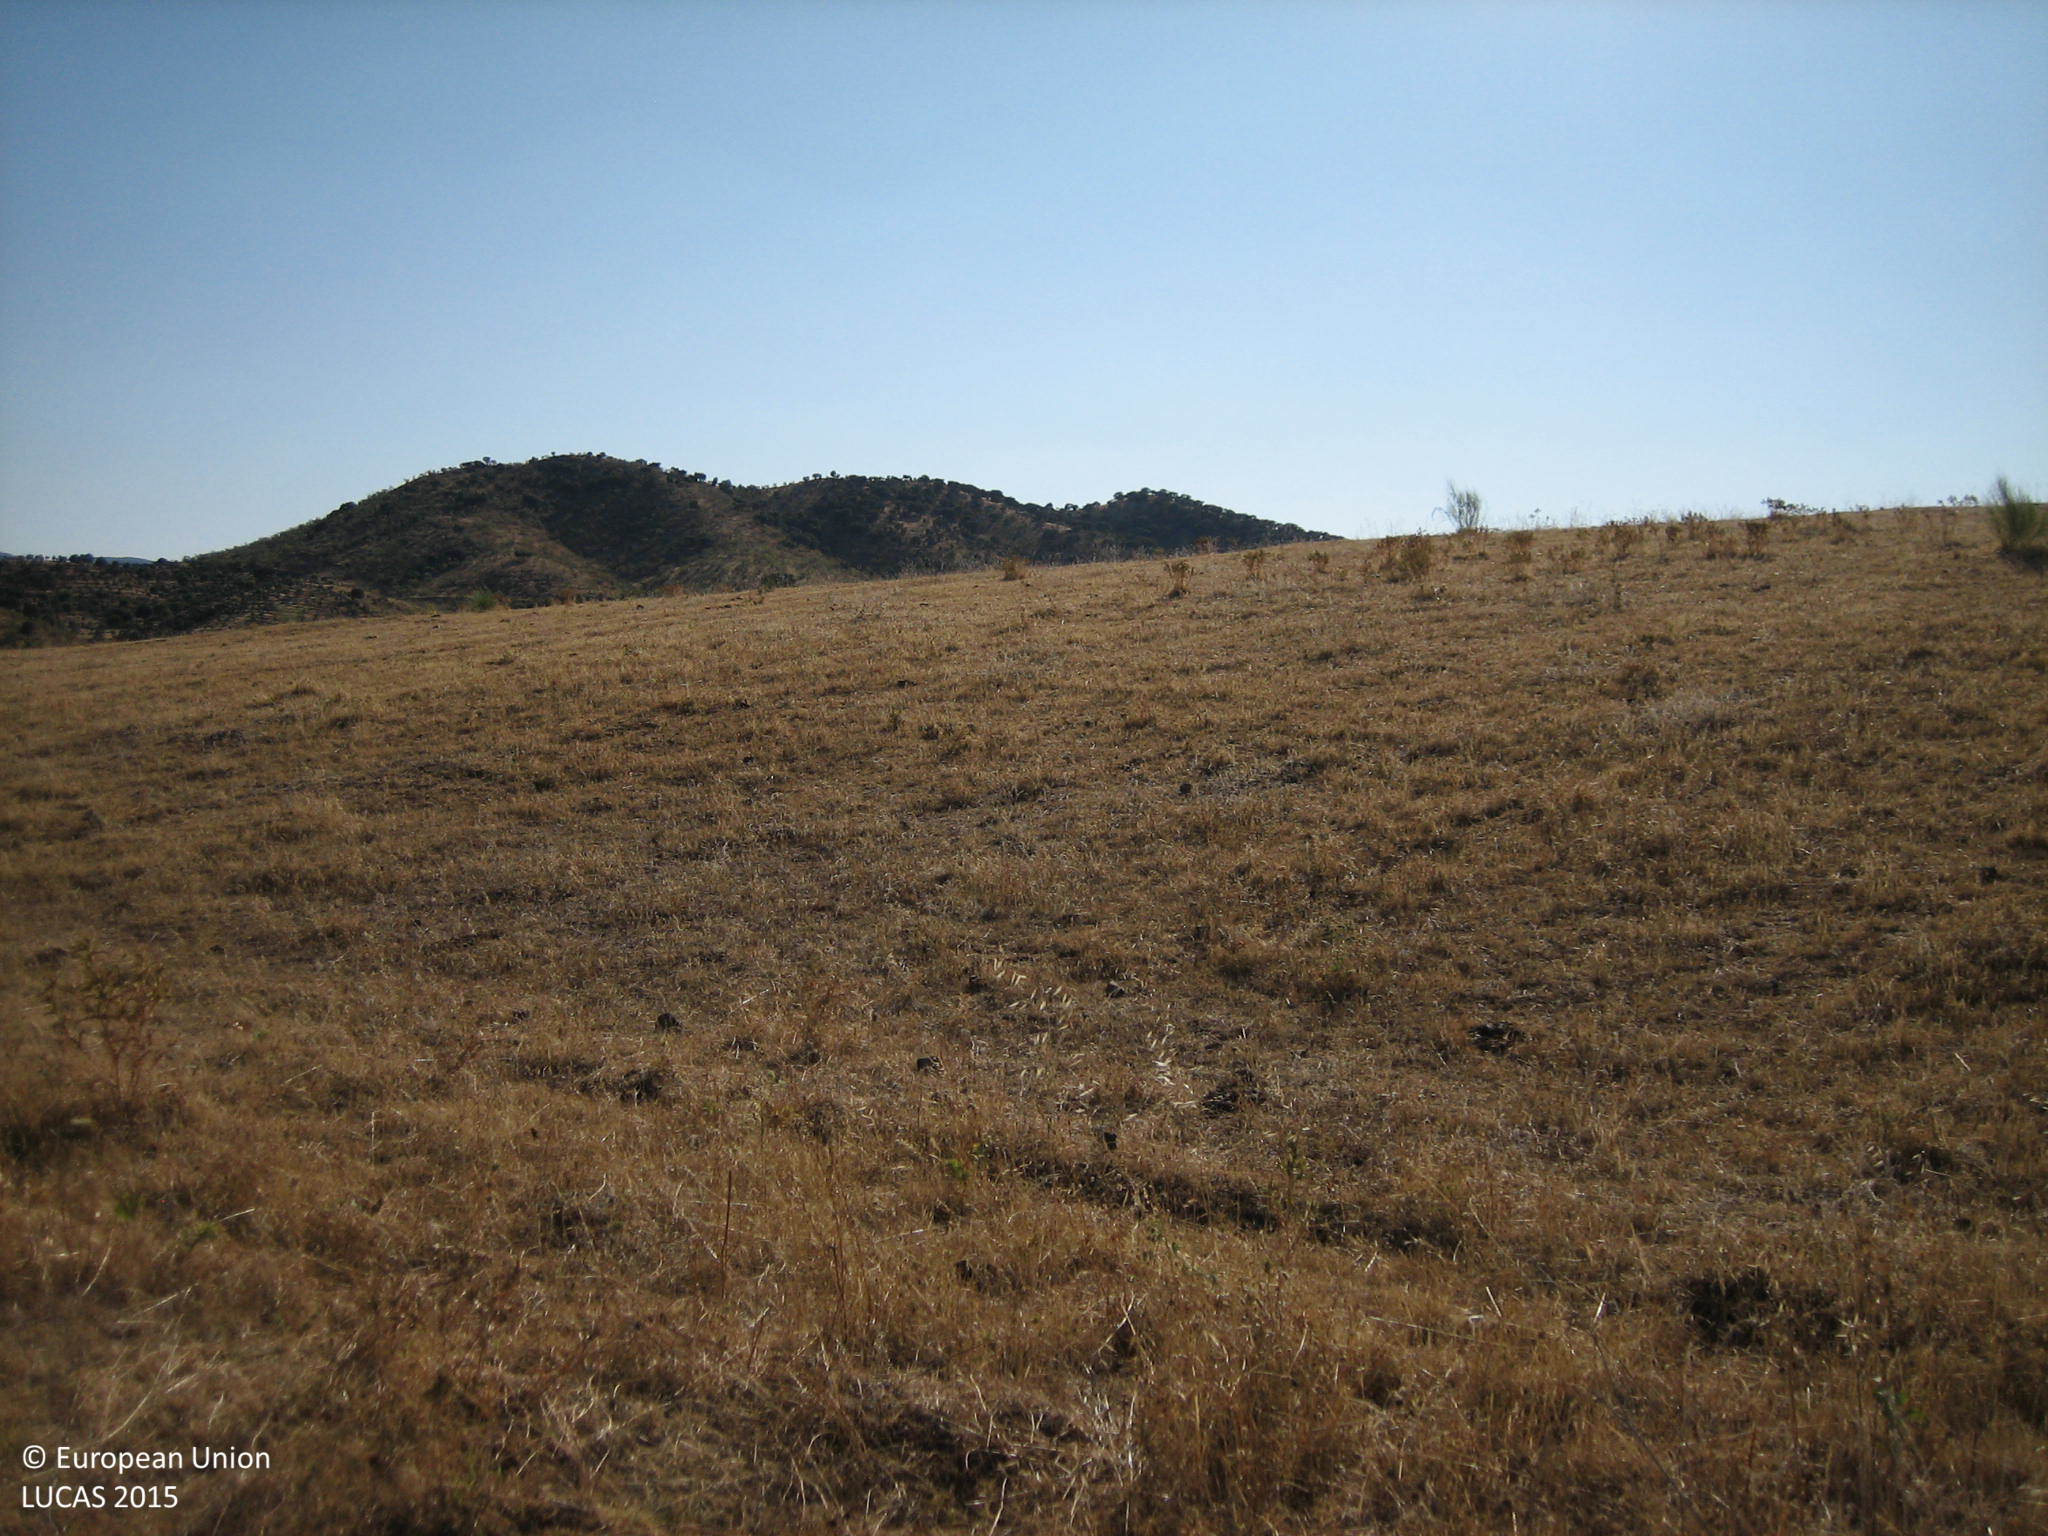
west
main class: Grassland
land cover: Grassland without tree/shrub cover
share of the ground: > 75 %
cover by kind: herbaceous plants 80 %, unconsolidated bare surface 20 %
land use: Agriculture (excluding fallow land and kitchen gardens)
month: July
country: ES
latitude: 38.0525
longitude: -6.0485
